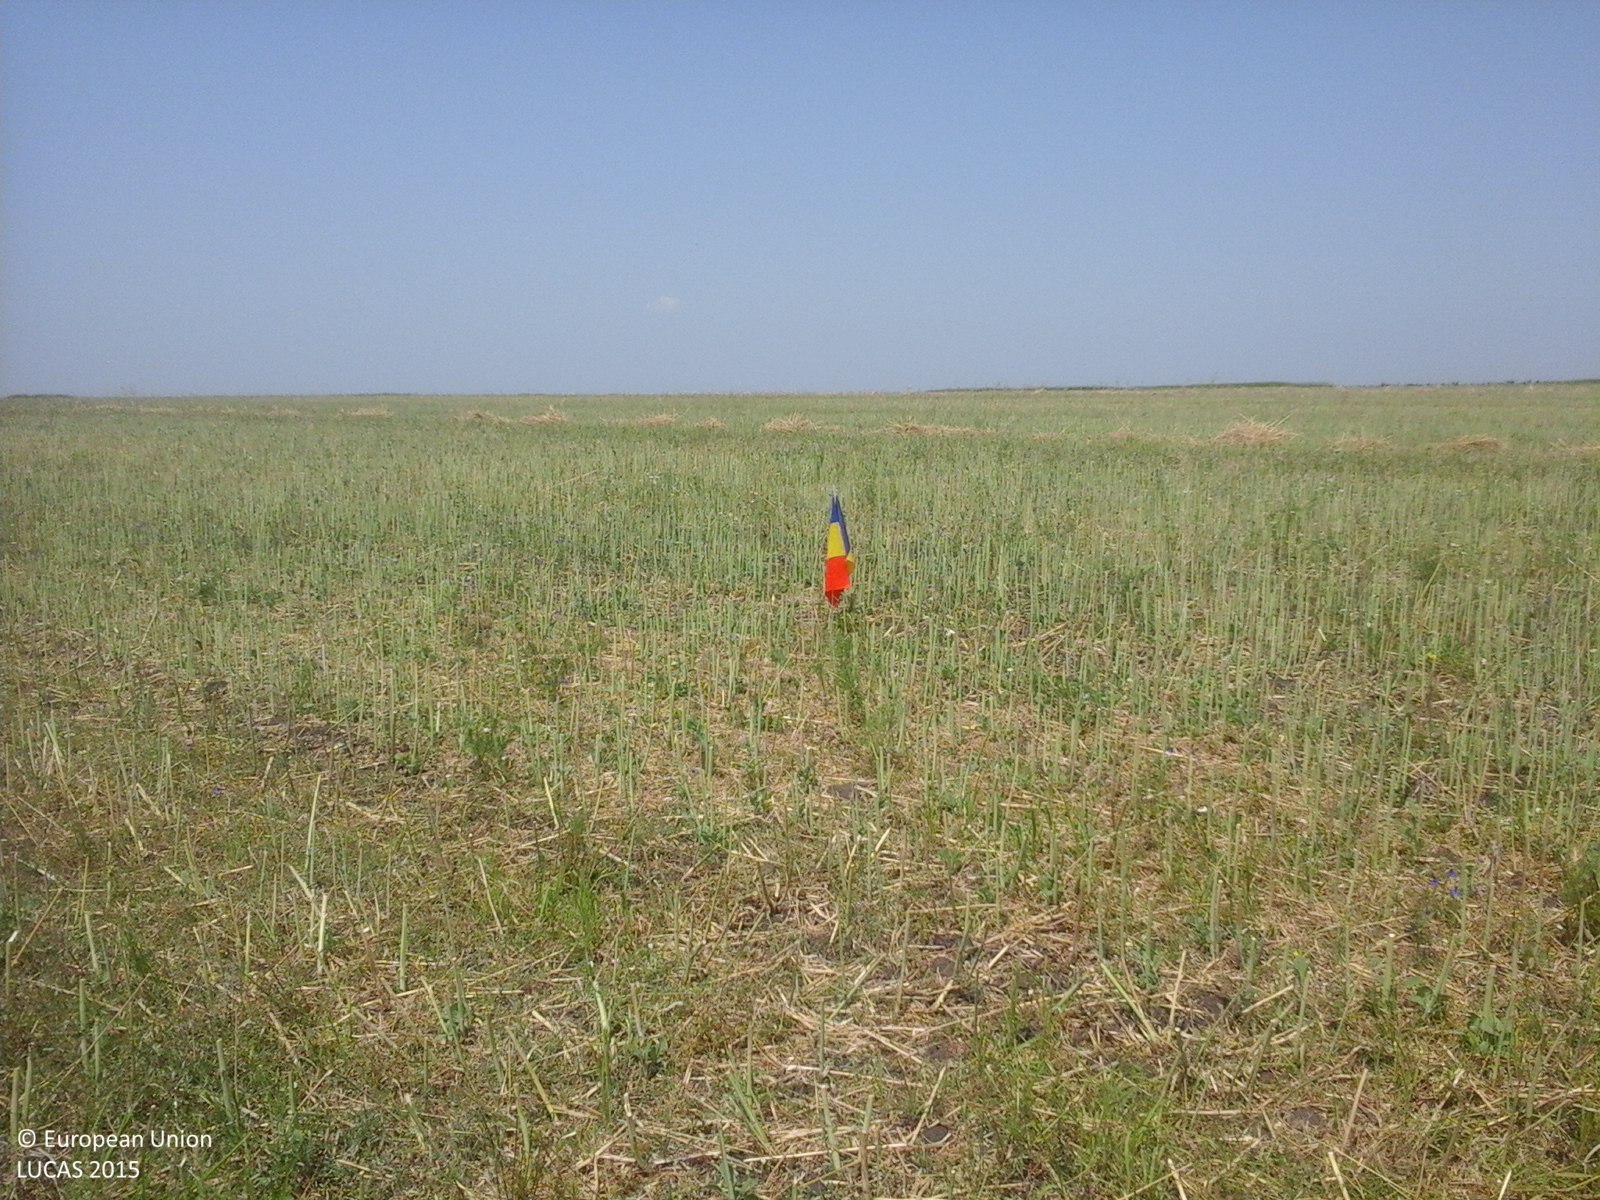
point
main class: Cropland
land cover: Rape and turnip rape
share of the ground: 10 - 25 %
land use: Agriculture (excluding fallow land and kitchen gardens)
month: July
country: RO
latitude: 44.4518
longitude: 24.8175
